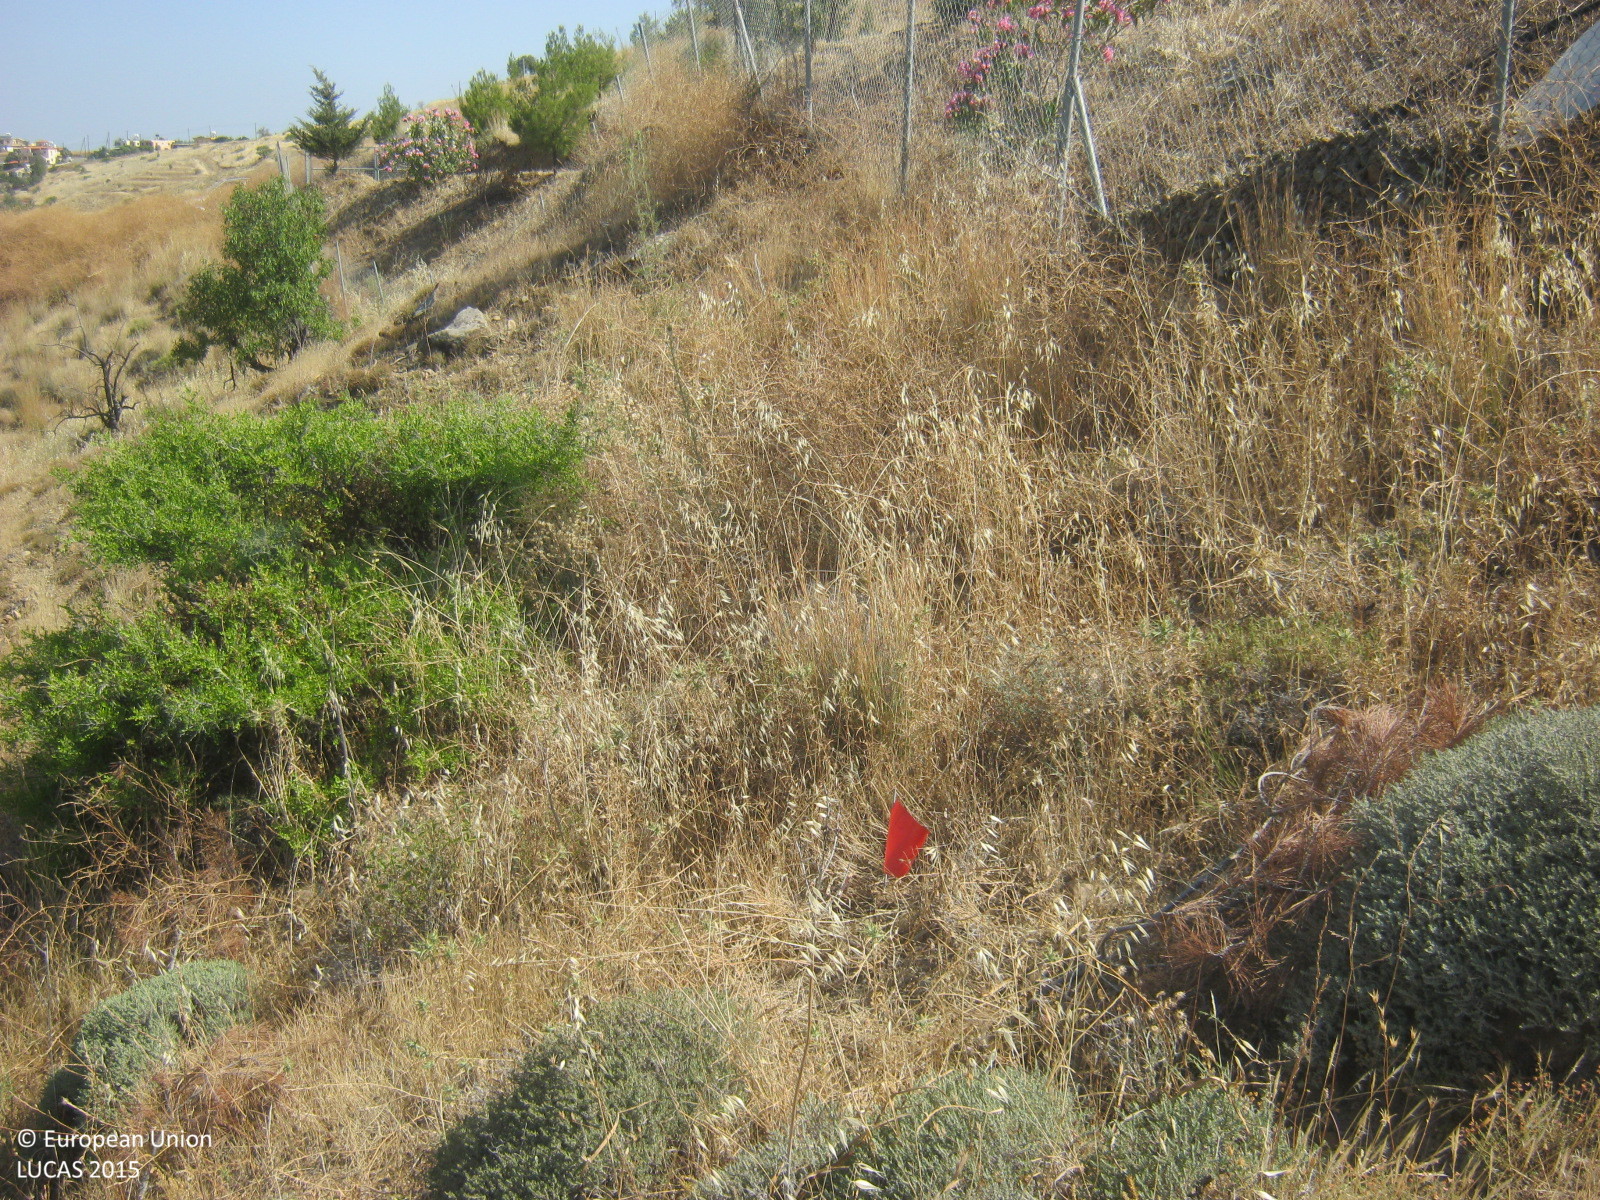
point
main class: Shrubland
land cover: Shrubland without tree cover
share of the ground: 25 - 50 %
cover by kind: herbaceous plants 55 %, shrubs 35 %, unconsolidated bare surface 10 %
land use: Semi-natural and natural areas not in use
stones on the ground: 25 - 50 %
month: May
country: CY
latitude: 35.0703
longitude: 33.0194
